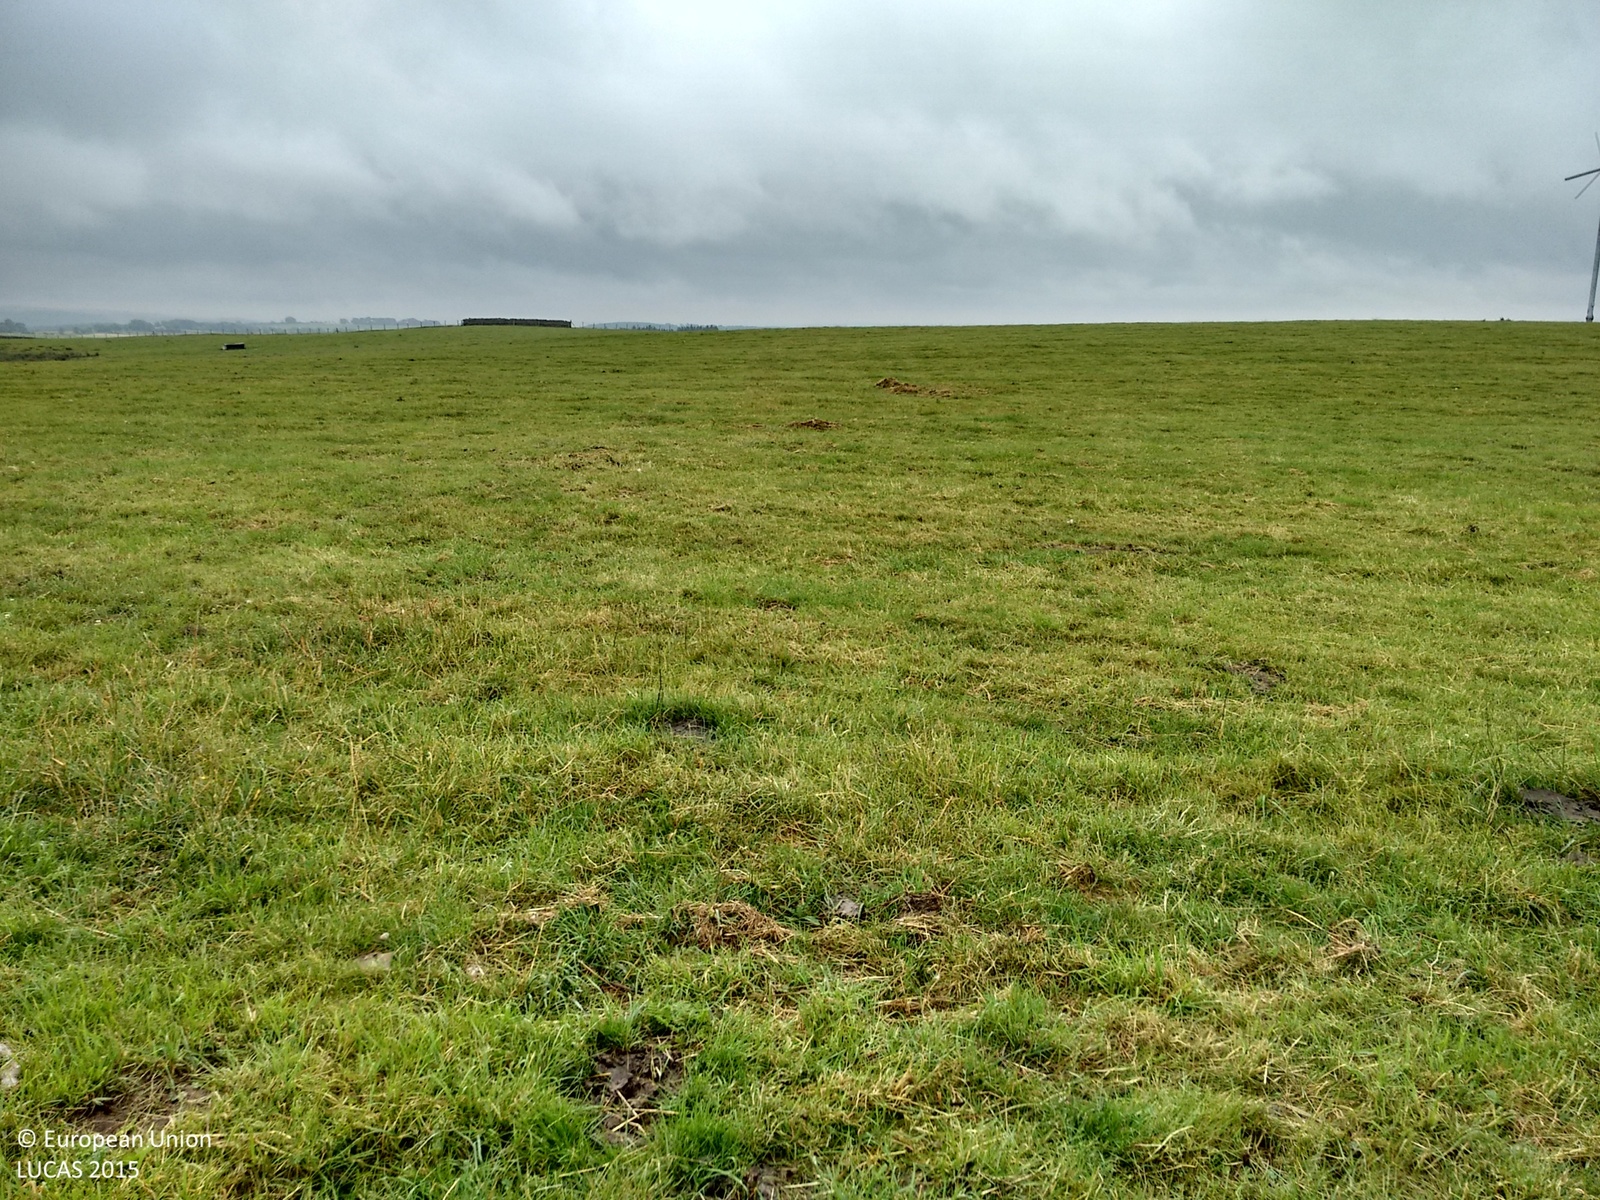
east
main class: Grassland
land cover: Grassland without tree/shrub cover
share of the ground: > 75 %
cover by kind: herbaceous plants 100 %
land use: Agriculture (excluding fallow land and kitchen gardens)
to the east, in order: Grassland without tree/shrub cover; Dry stone walls; Fences; Grassland without tree/shrub cover
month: July
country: GB
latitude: 54.5894
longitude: -1.9553
